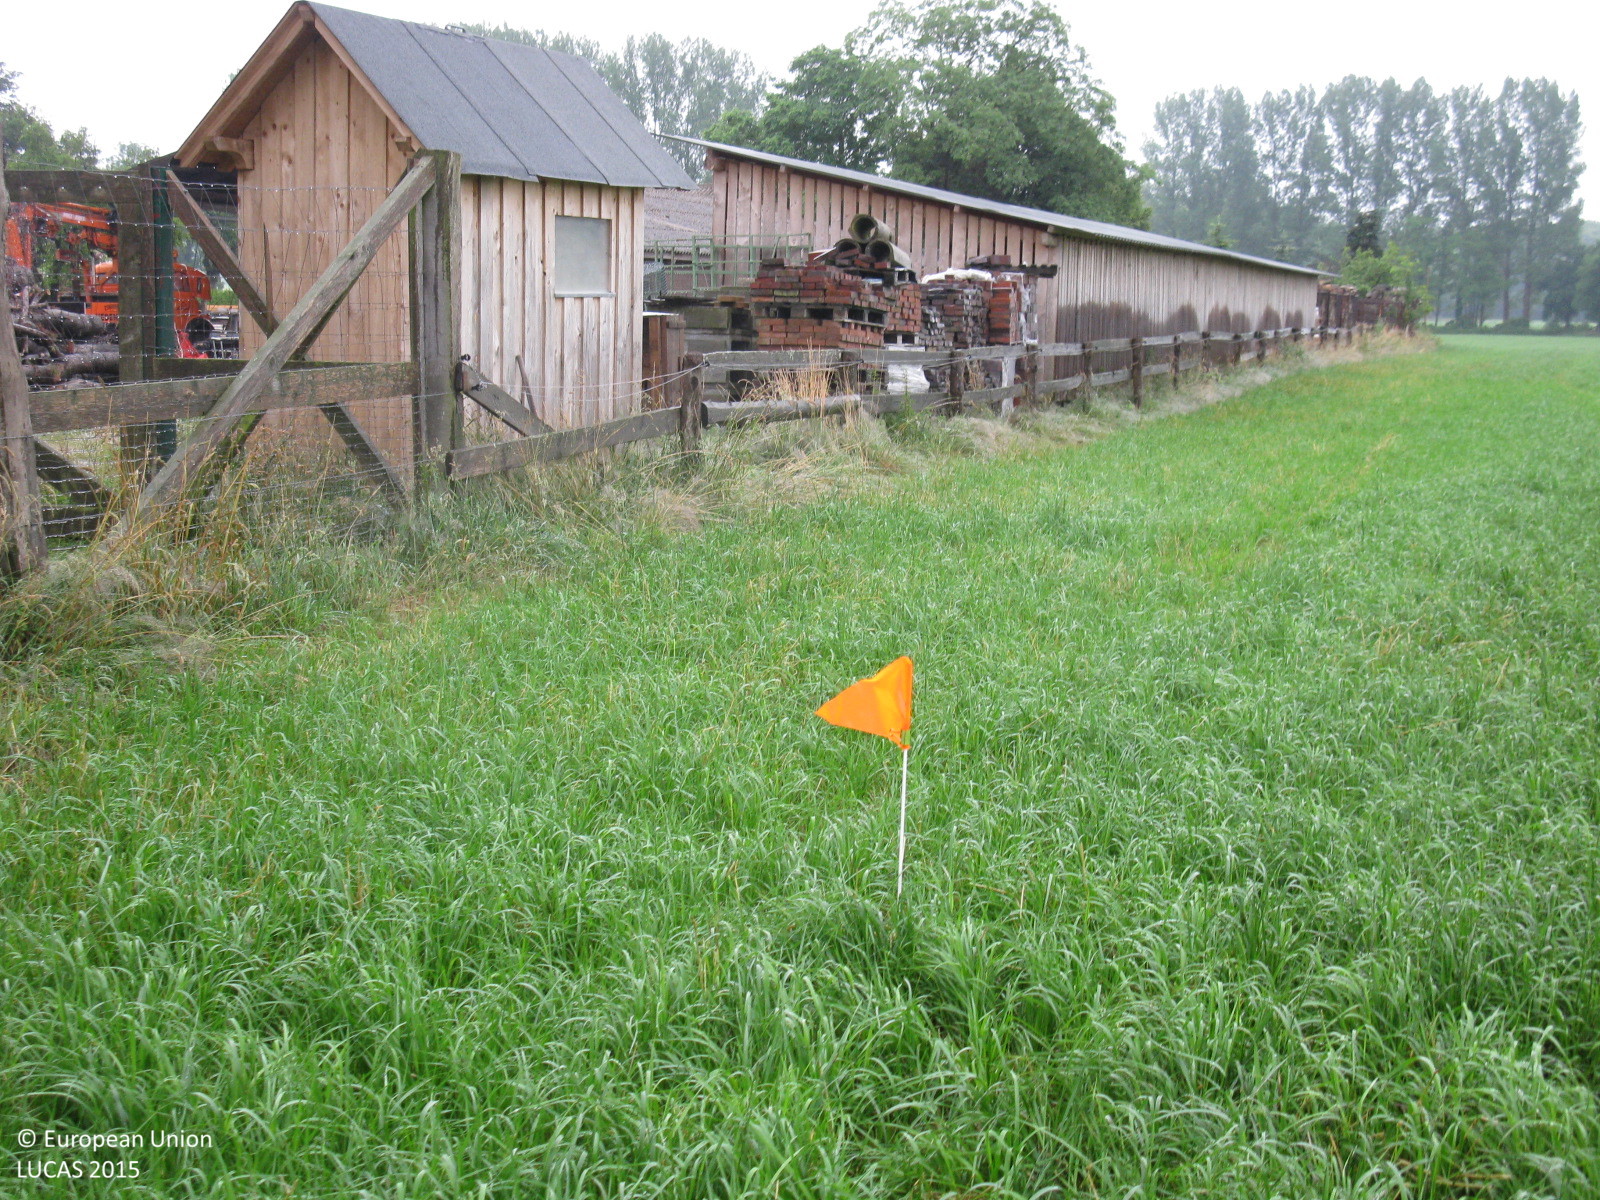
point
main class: Grassland
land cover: Grassland without tree/shrub cover
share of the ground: > 75 %
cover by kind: herbaceous plants 100 %
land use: Agriculture (excluding fallow land and kitchen gardens)
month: July
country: DE
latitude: 53.2772
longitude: 7.9761
